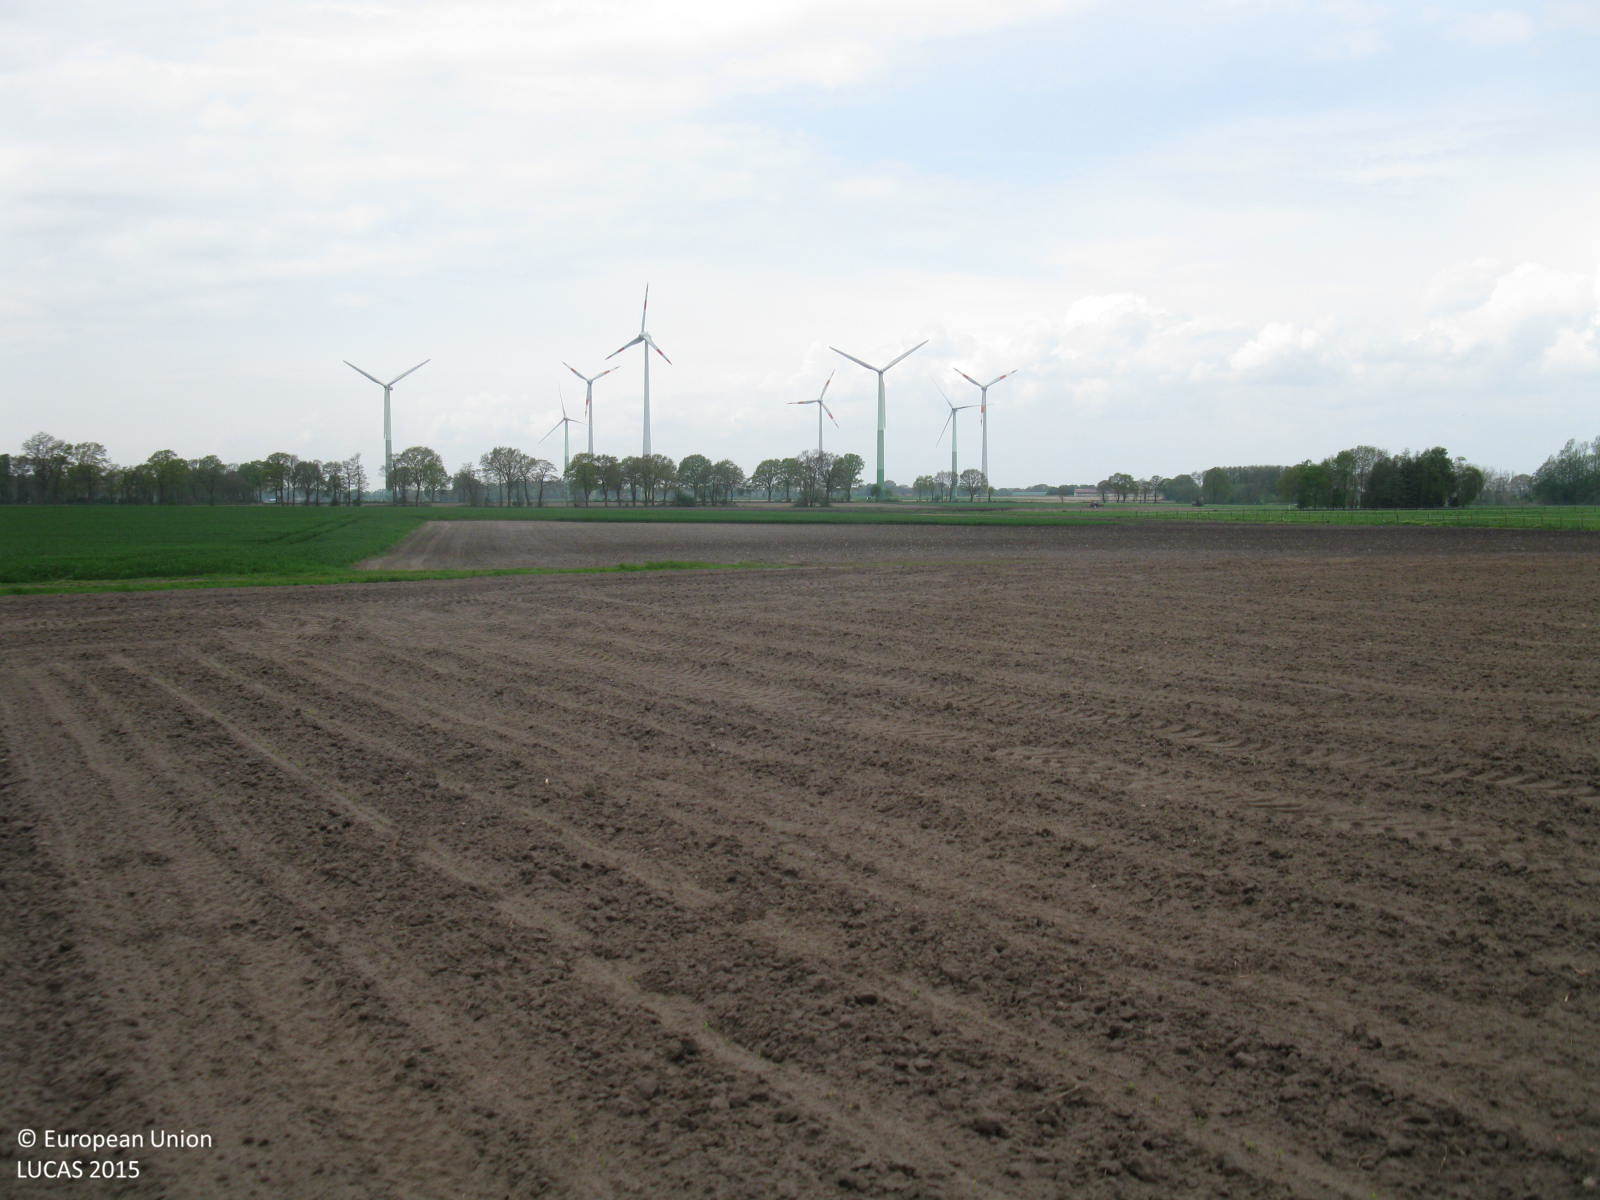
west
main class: Cropland
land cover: Maize
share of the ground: < 10 %
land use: Agriculture (excluding fallow land and kitchen gardens)
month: May
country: DE
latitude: 52.8265
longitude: 7.9080
